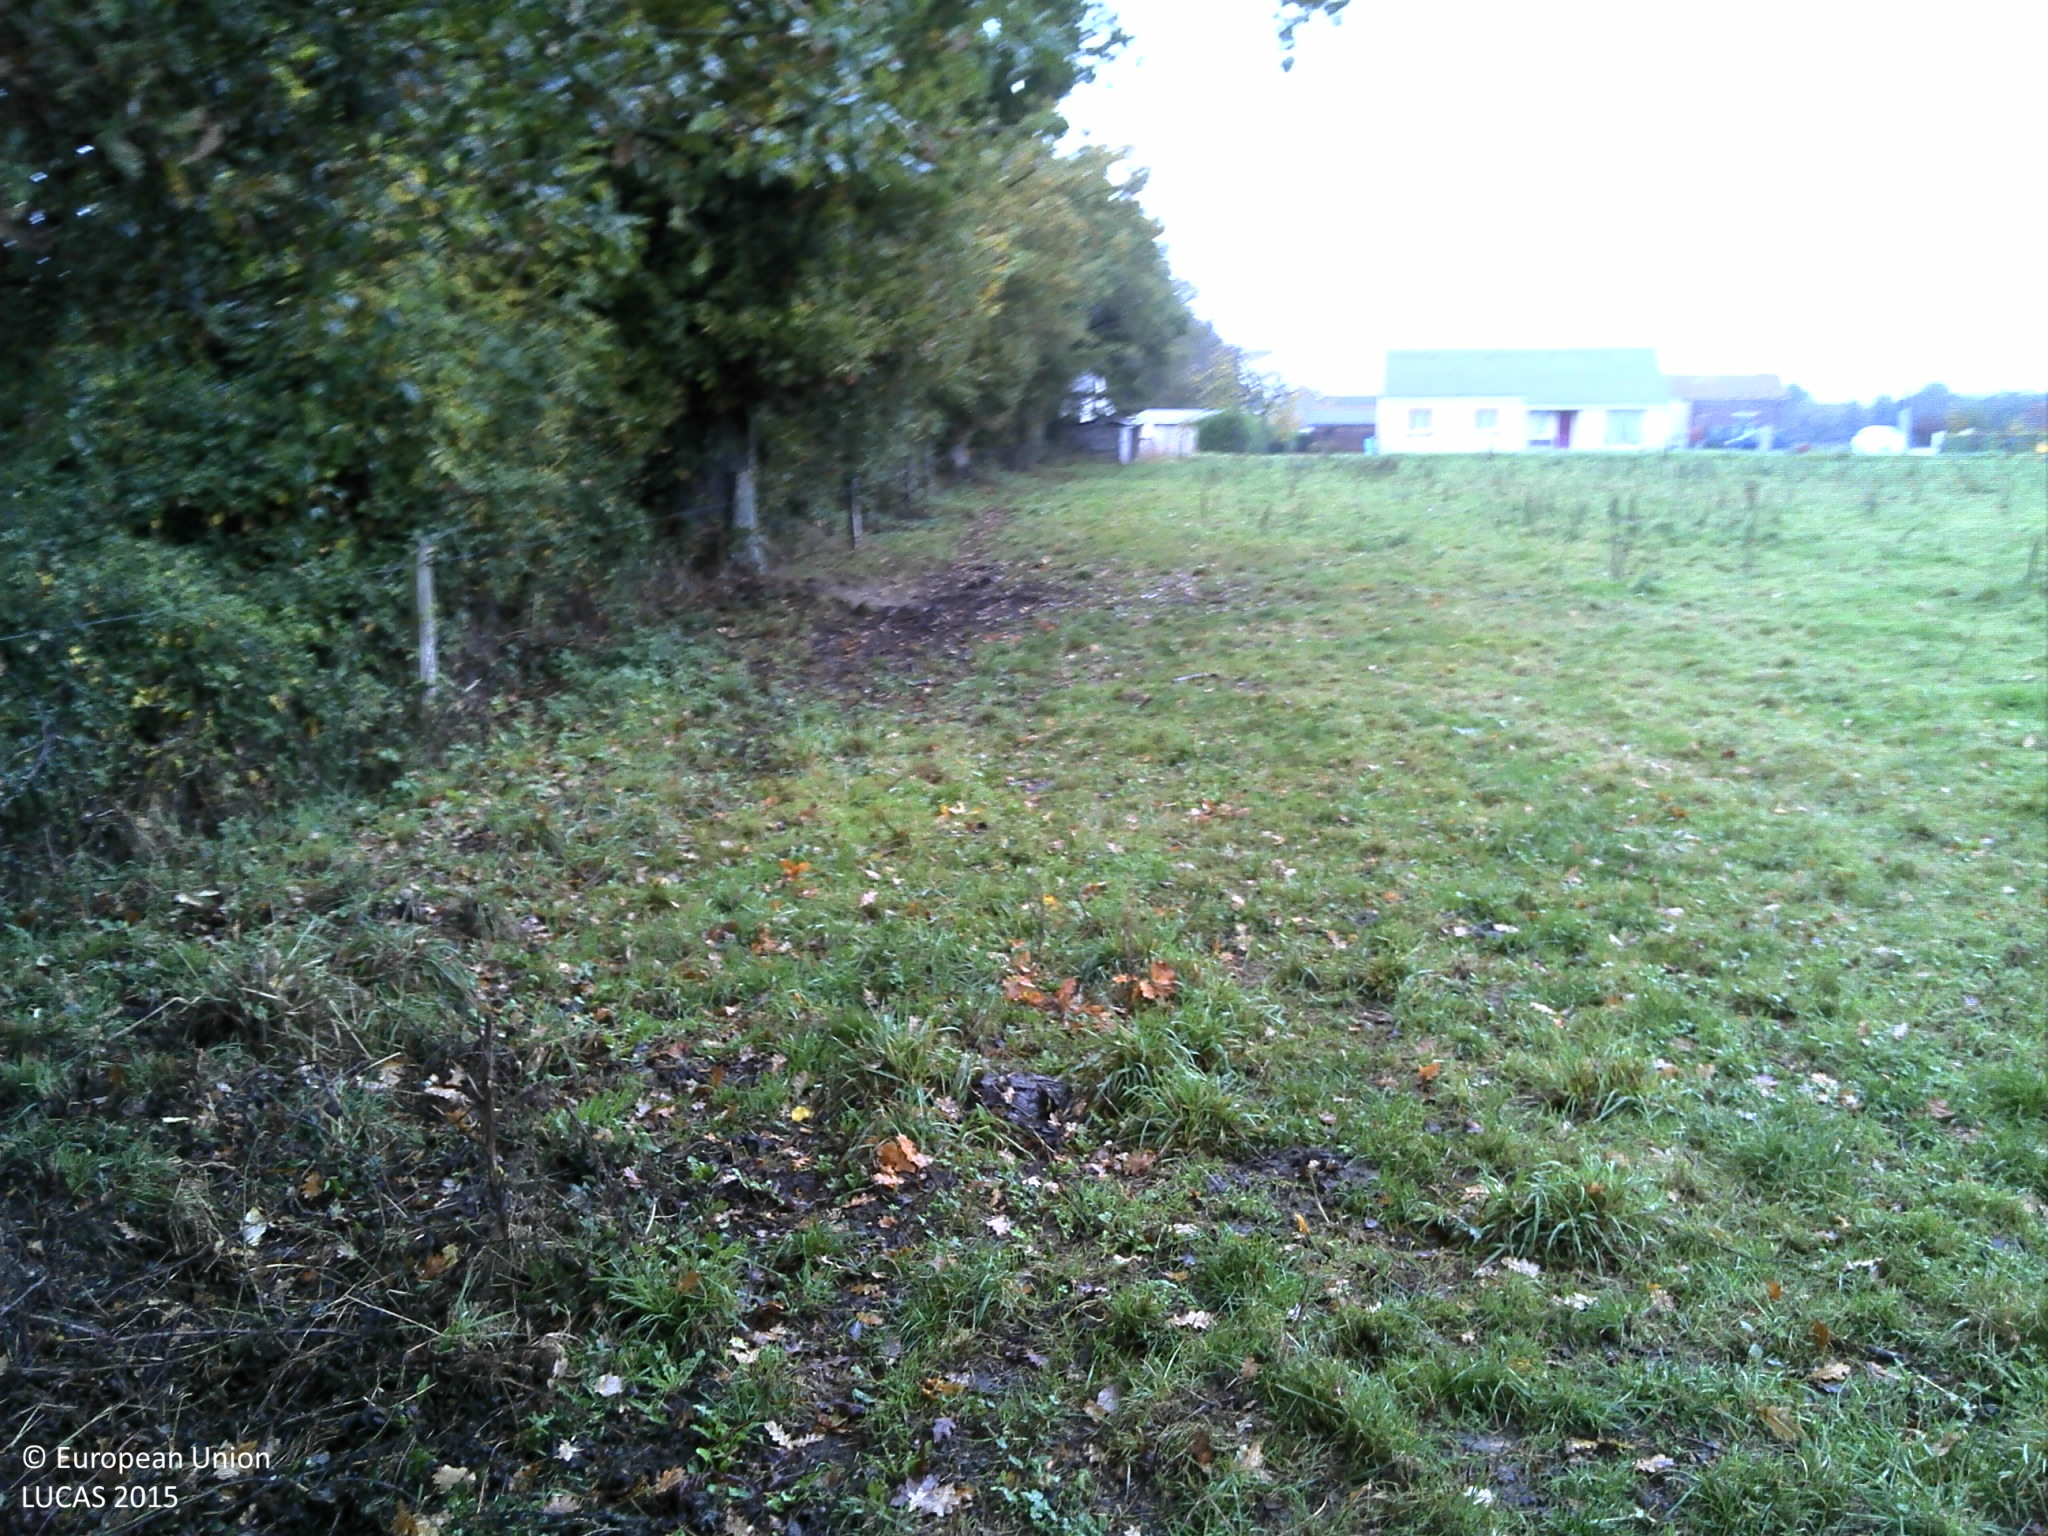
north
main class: Cropland
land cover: Temporary grasslands
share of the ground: > 75 %
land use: Agriculture (excluding fallow land and kitchen gardens)
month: November
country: FR
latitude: 47.6168
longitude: -1.5256
